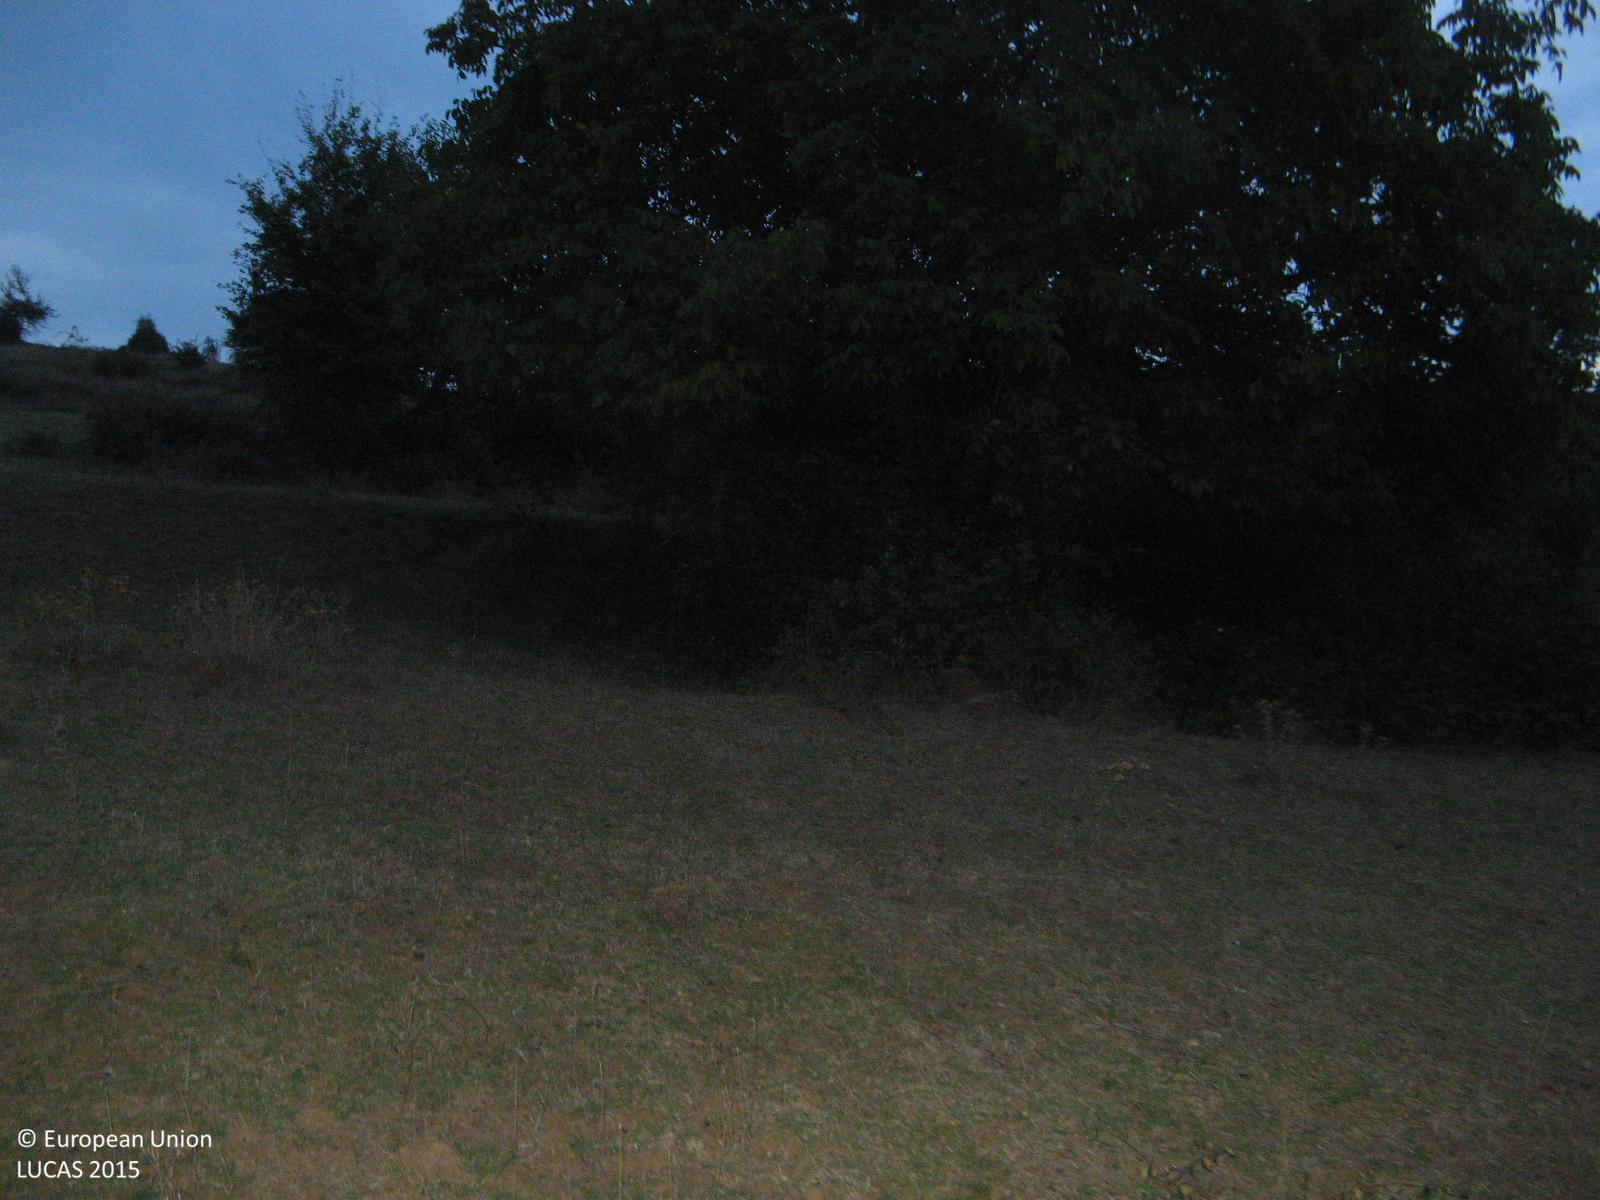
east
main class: Grassland
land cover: Grassland with sparse tree/shrub cover
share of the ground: > 75 %
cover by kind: herbaceous plants 85 %, shrubs 10 %, broadleaved forest trees 5 %
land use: Agriculture (excluding fallow land and kitchen gardens)
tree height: > 5 m
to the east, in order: Grassland with sparse tree/shrub cover; Groves; Grassland with sparse tree/shrub cover; Broadleaved woodland
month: October
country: BG
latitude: 41.6993
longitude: 25.3296
